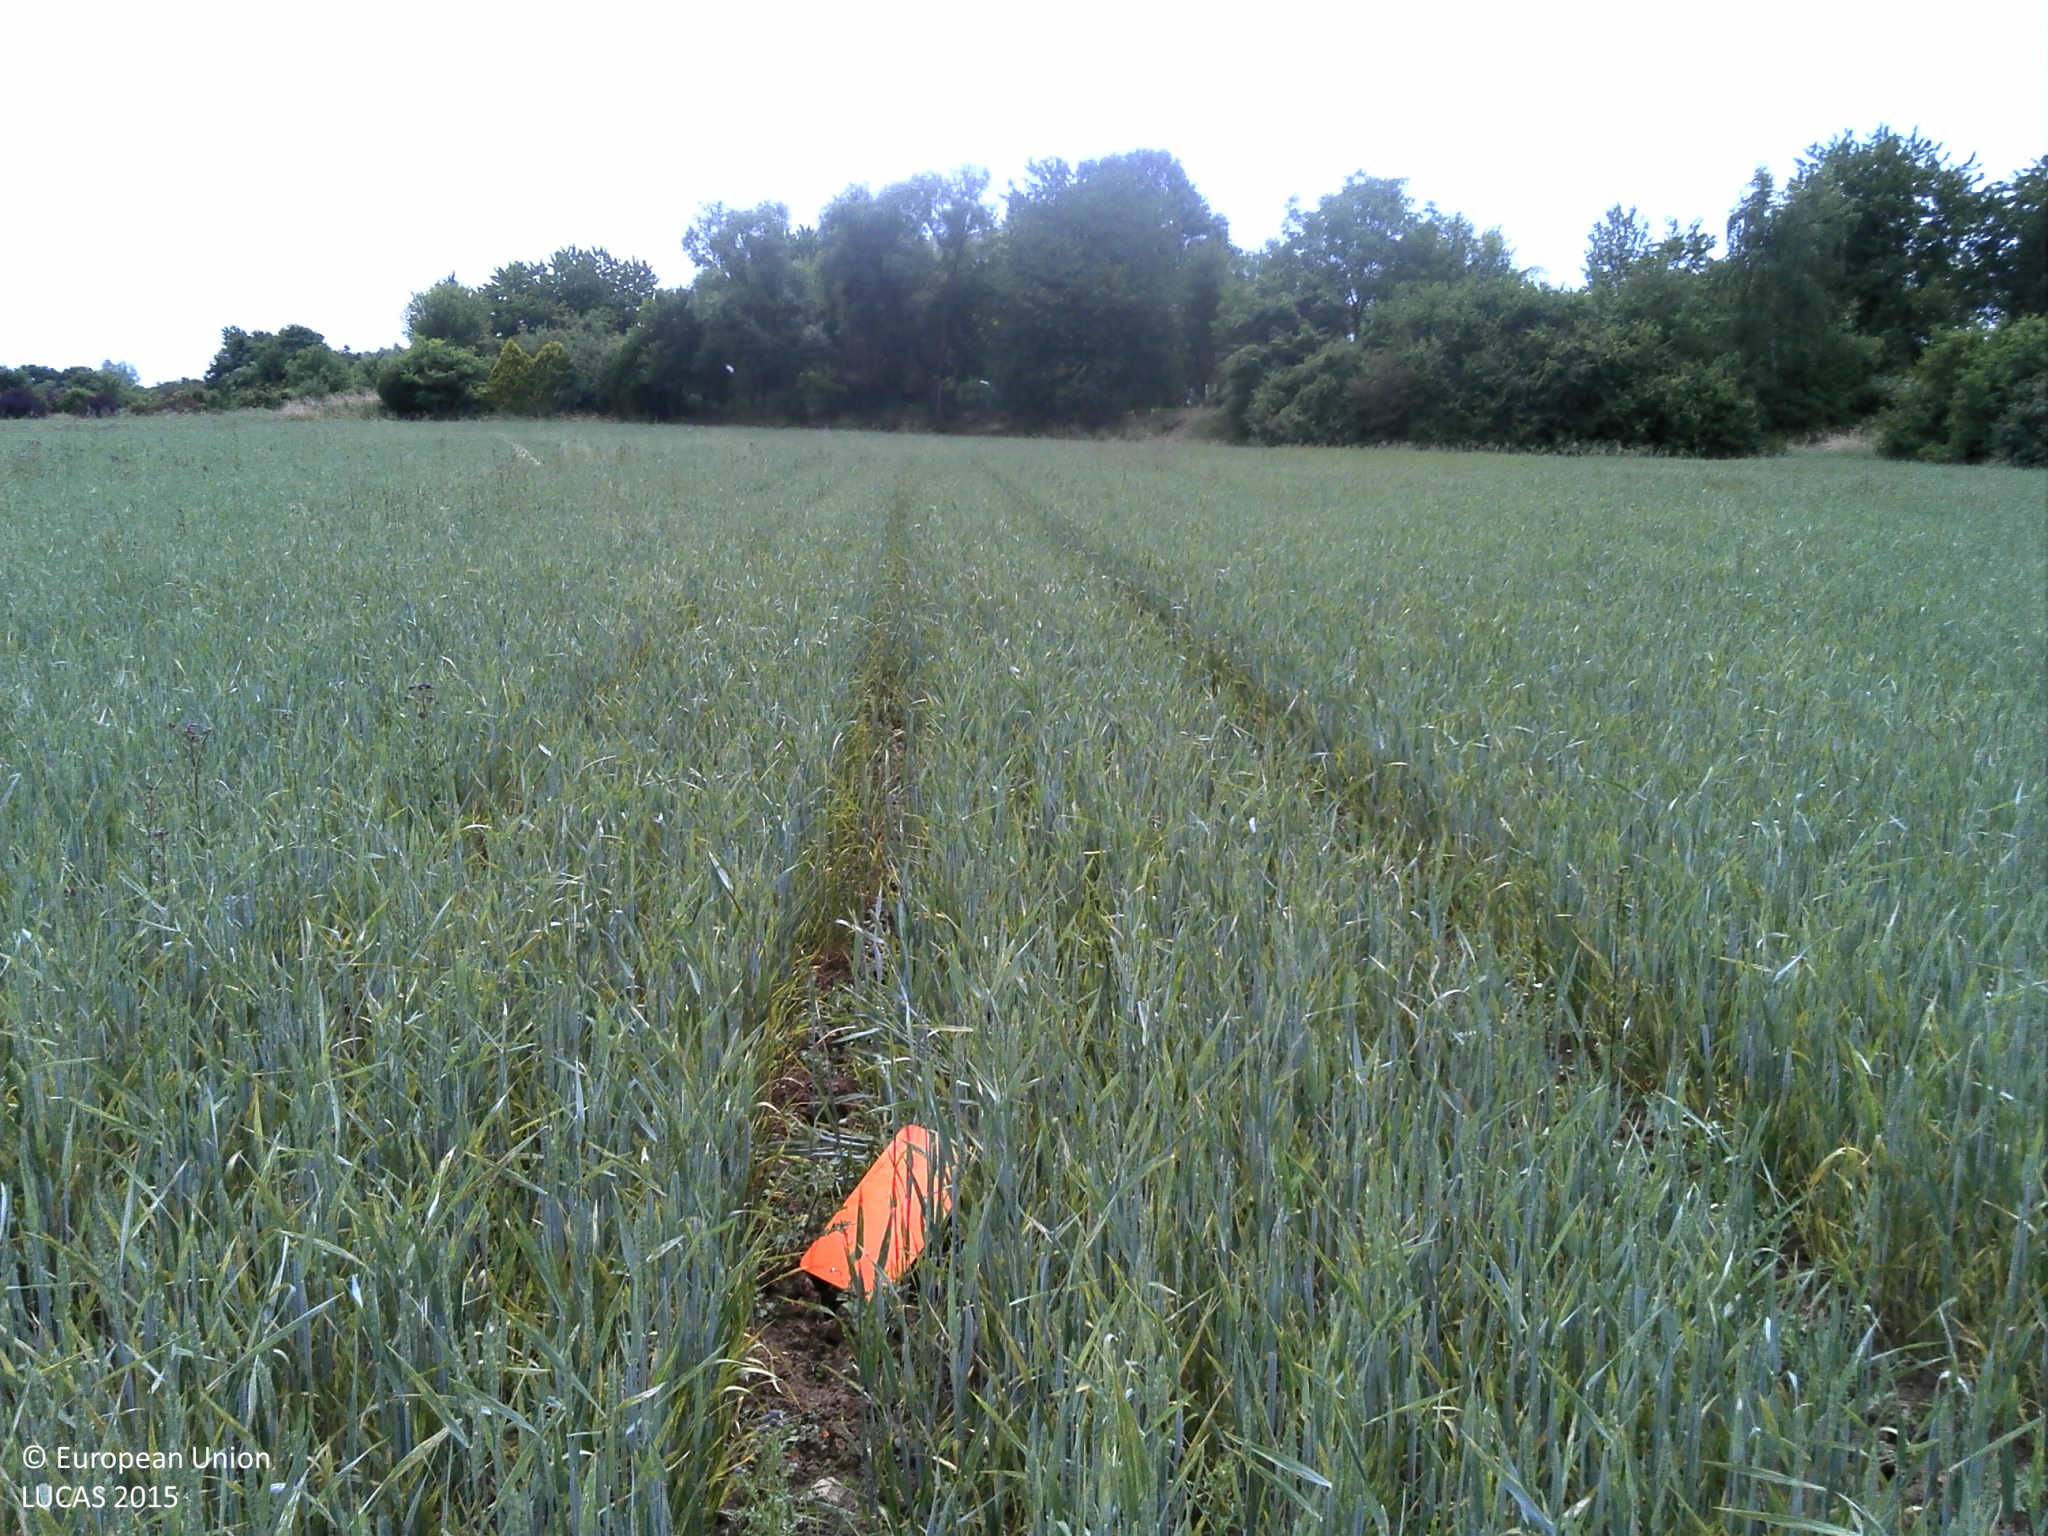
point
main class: Cropland
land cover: Barley
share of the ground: > 75 %
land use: Agriculture (excluding fallow land and kitchen gardens)
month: June
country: FR
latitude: 49.3113
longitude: 6.2170
